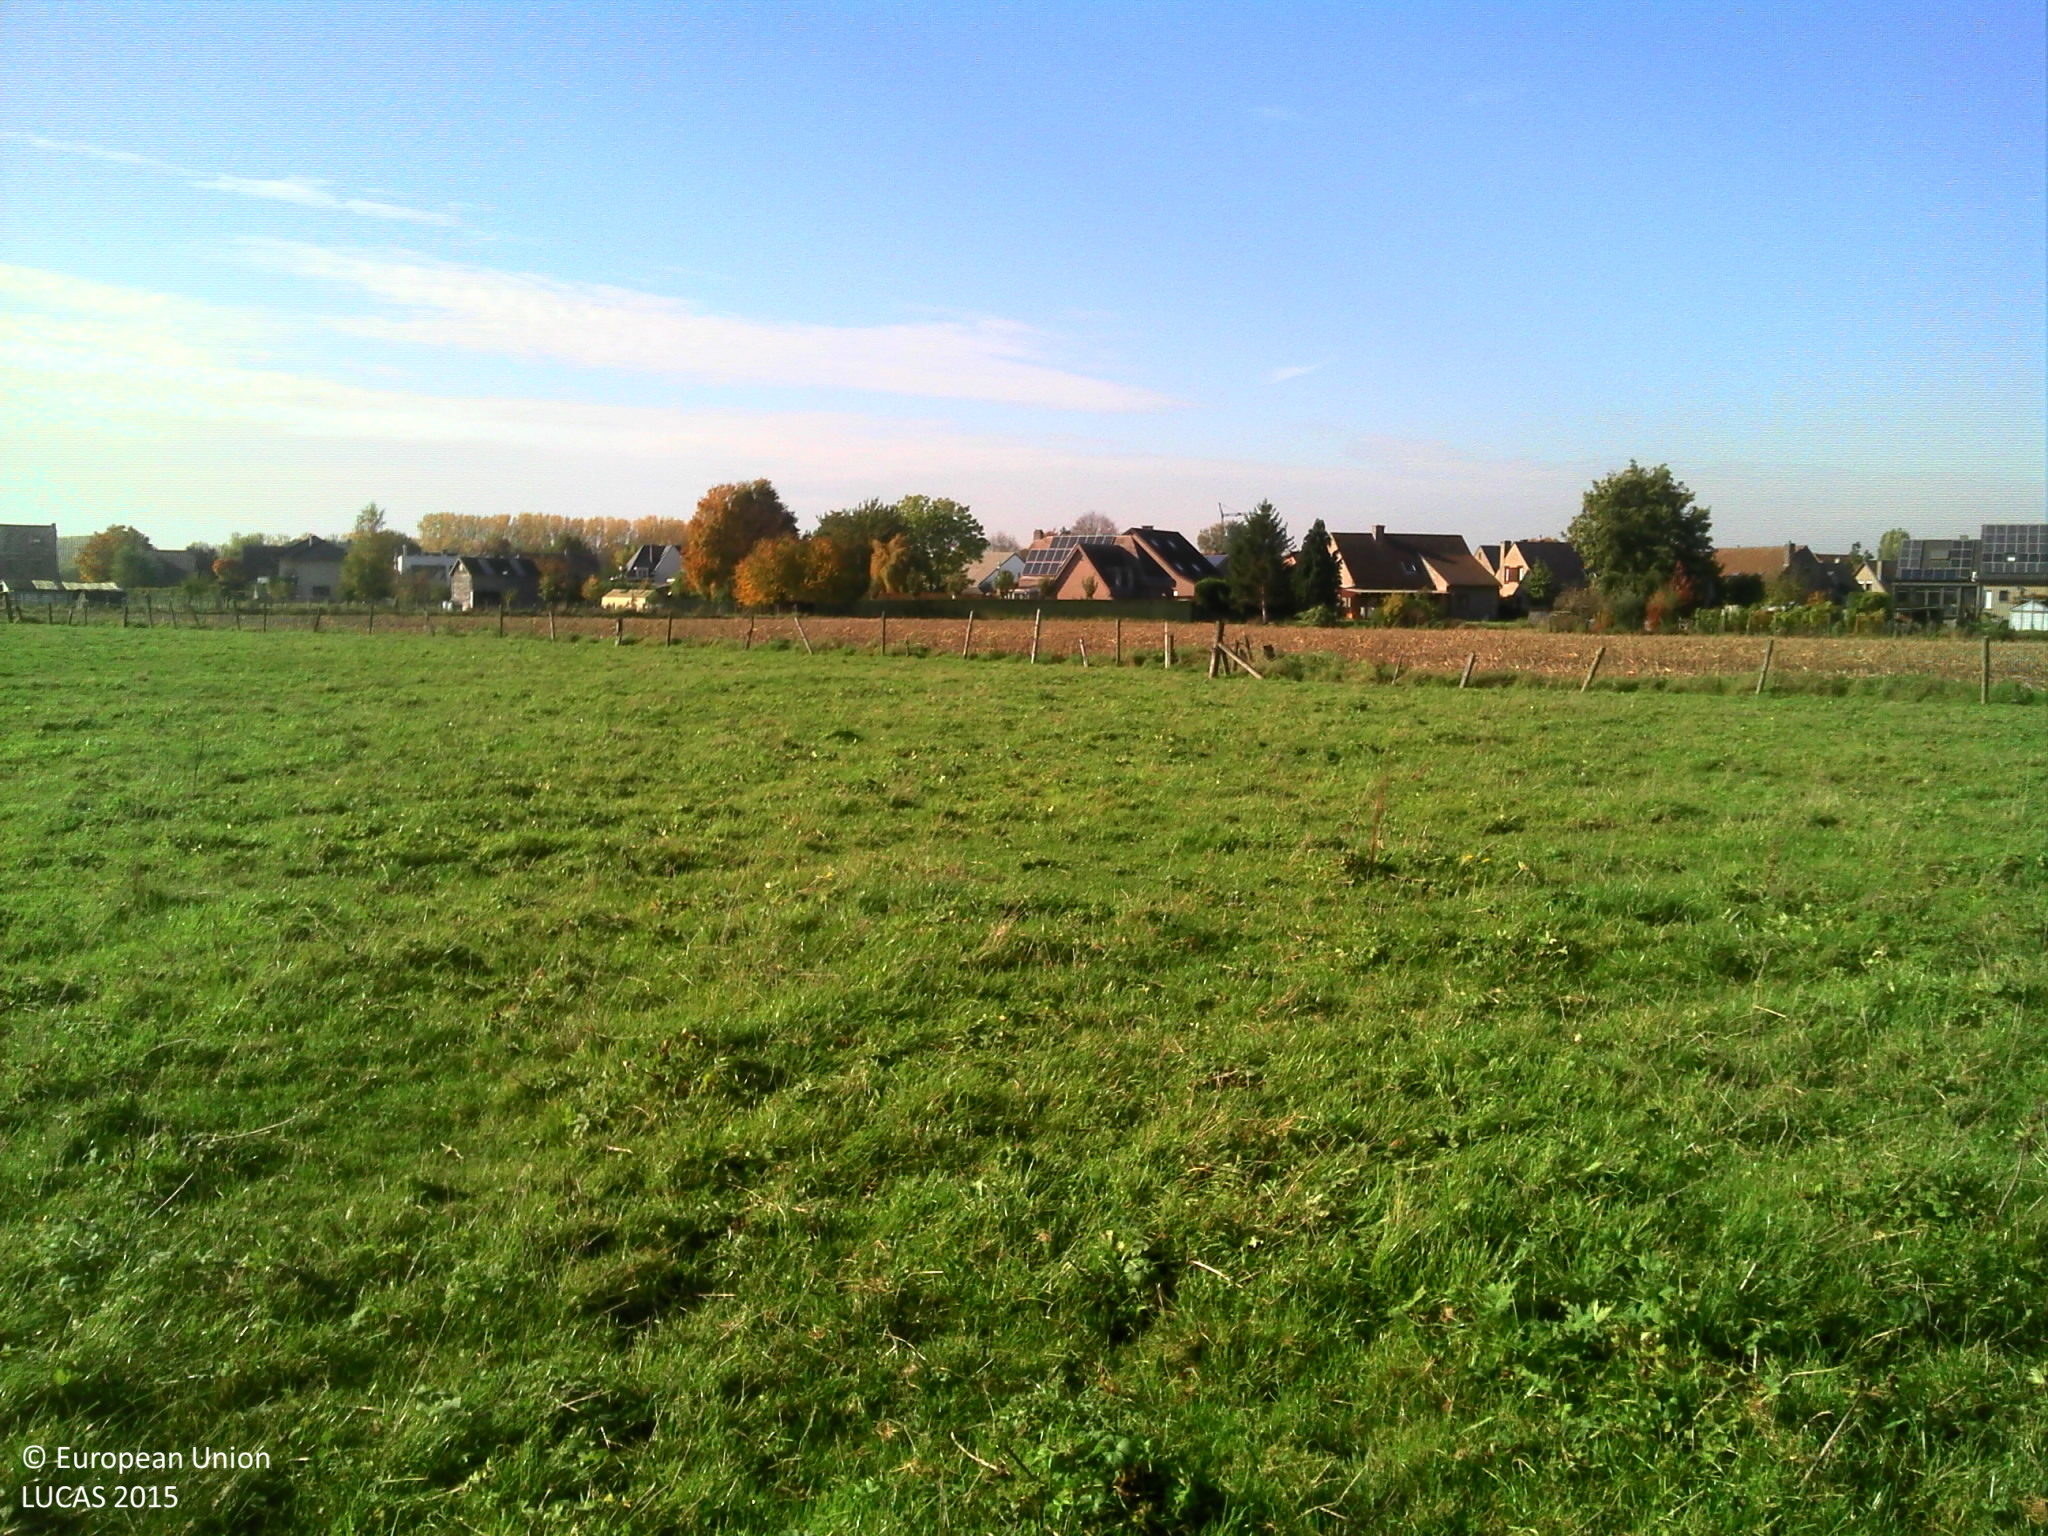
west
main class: Grassland
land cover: Grassland without tree/shrub cover
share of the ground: > 75 %
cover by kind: herbaceous plants 100 %
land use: Agriculture (excluding fallow land and kitchen gardens)
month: October
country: BE
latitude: 51.0003
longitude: 4.3667
